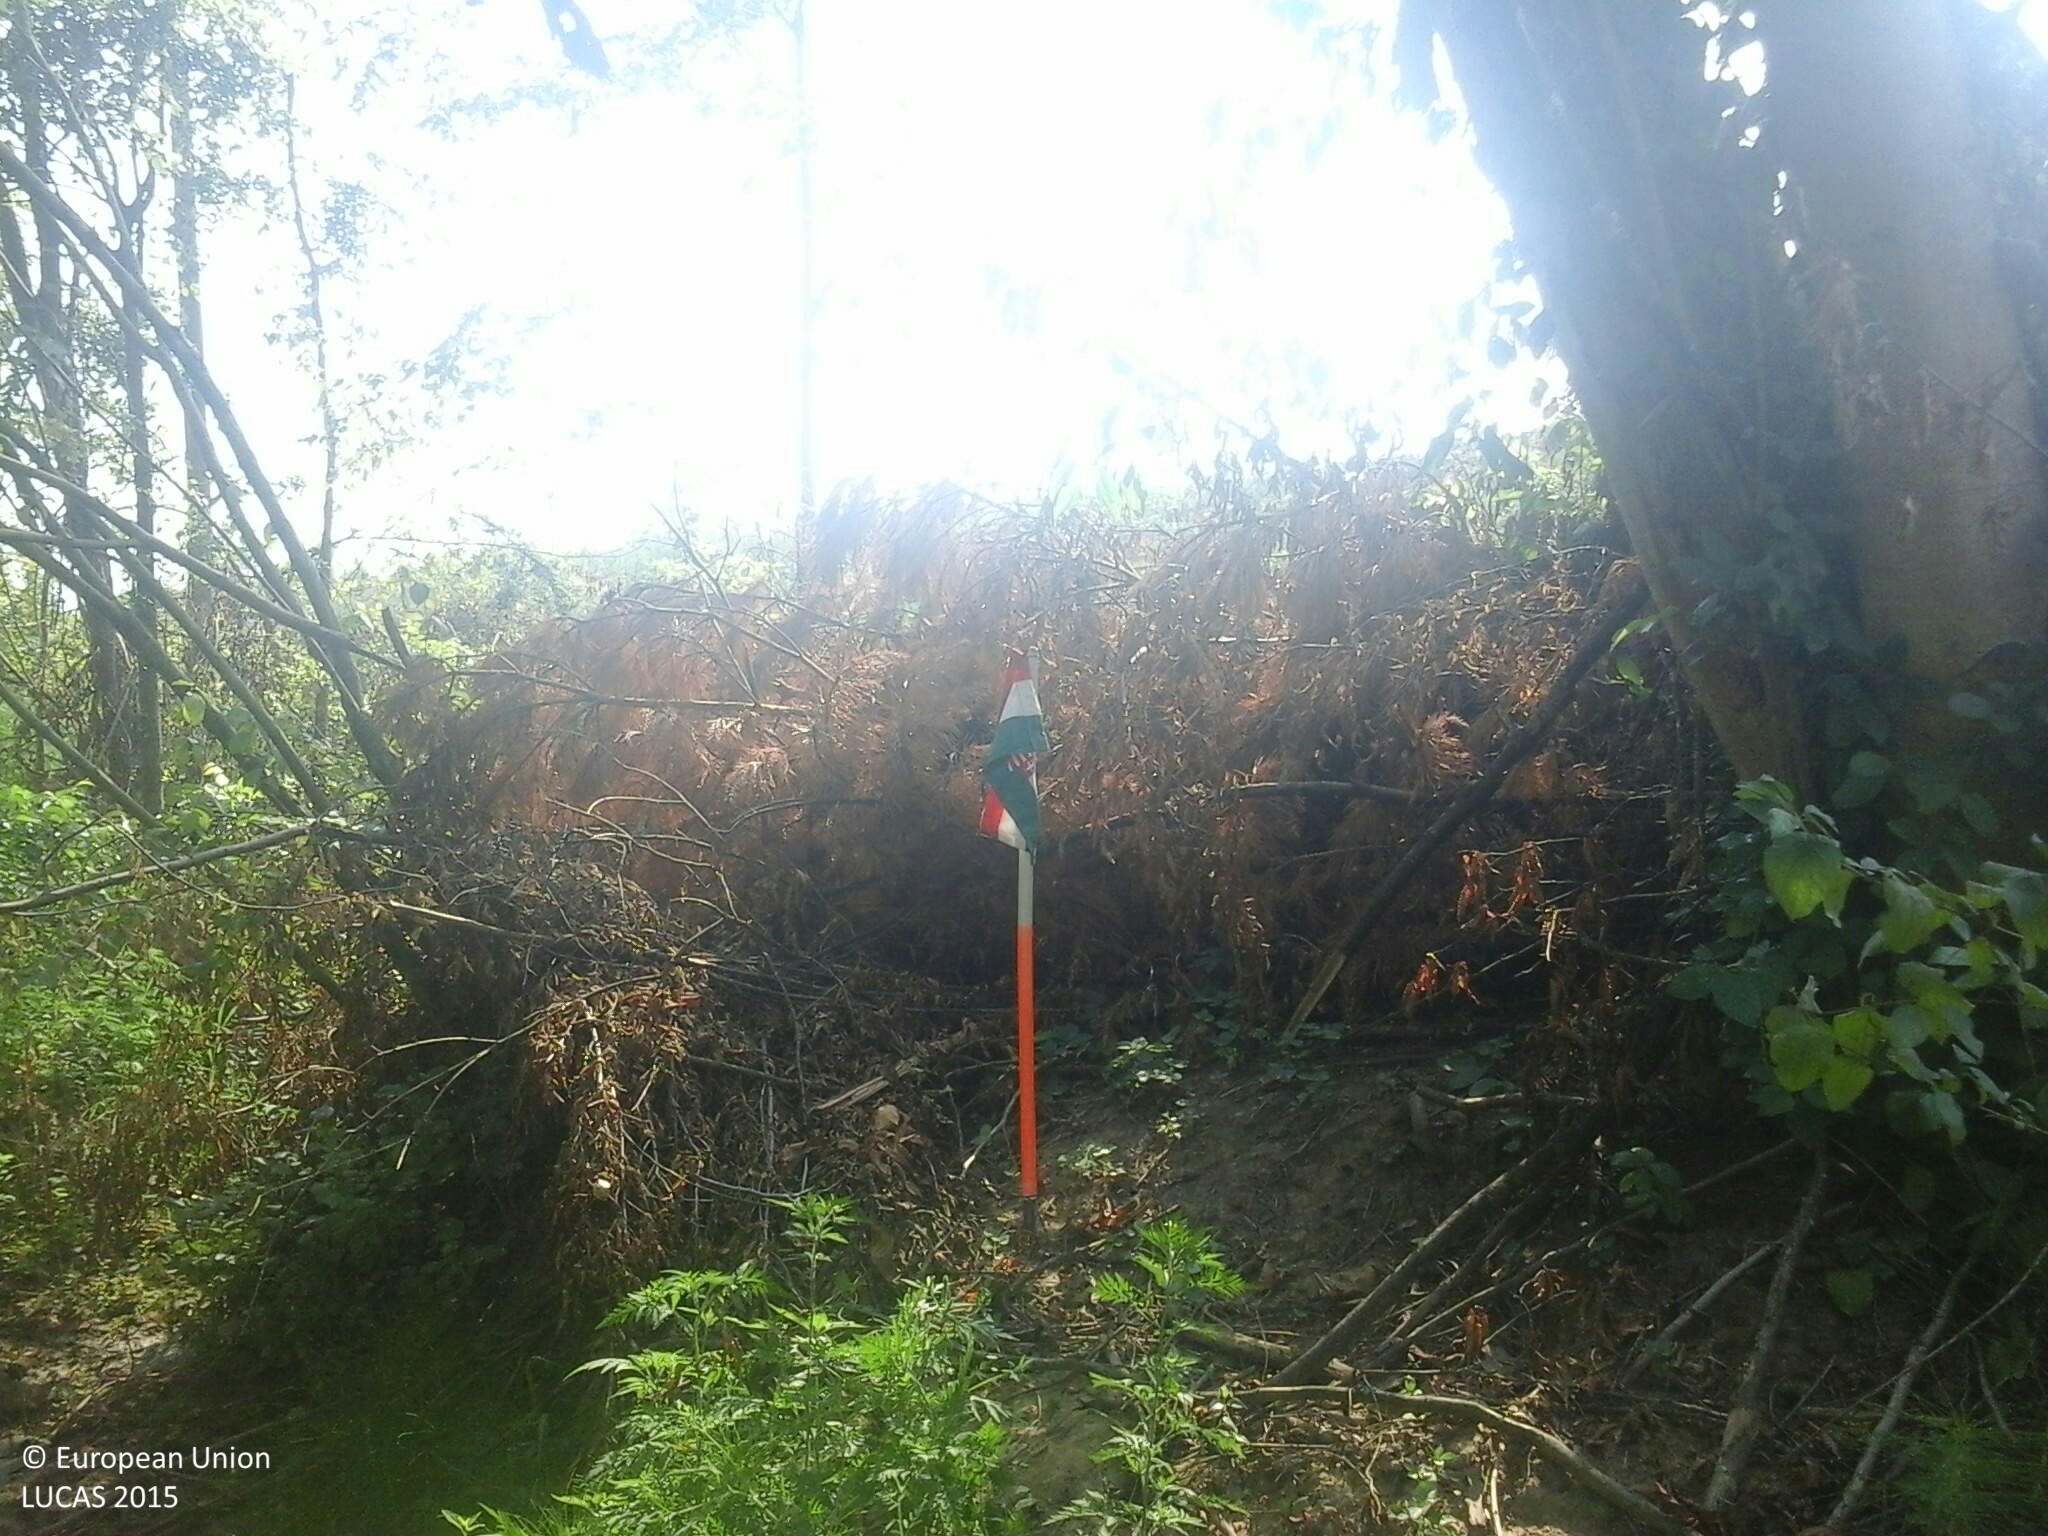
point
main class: Woodland
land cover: Broadleaved woodland
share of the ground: 50 - 75 %
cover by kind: broadleaved forest trees 50 %, shrubs 50 %
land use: Forestry
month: August
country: HU
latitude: 45.9576
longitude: 18.2775
